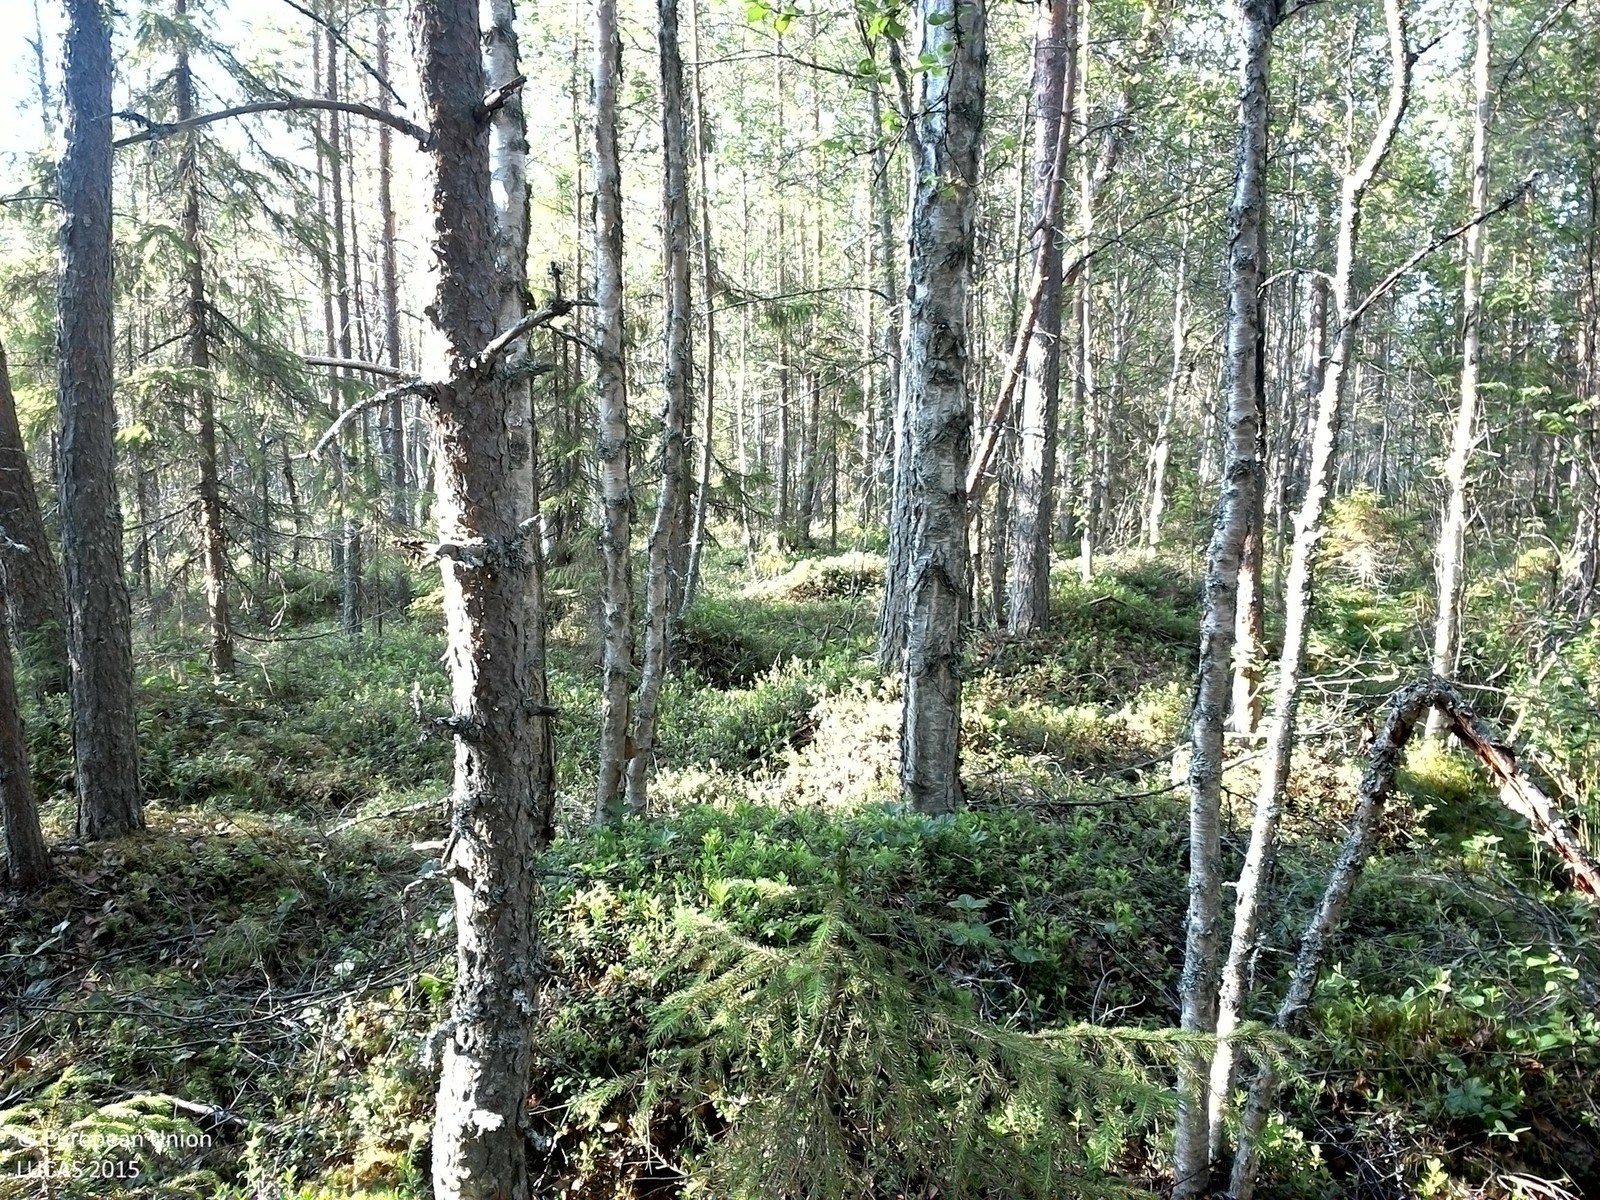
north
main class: Woodland
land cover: Other mixed woodland
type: boreal forest
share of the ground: 50 - 75 %
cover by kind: coniferous forest trees 35 %, broadleaved forest trees 30 %, shrubs 20 %, herbaceous plants 10 %
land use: Forestry
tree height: > 5 m
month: July
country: SE
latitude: 64.1483
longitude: 16.6912
